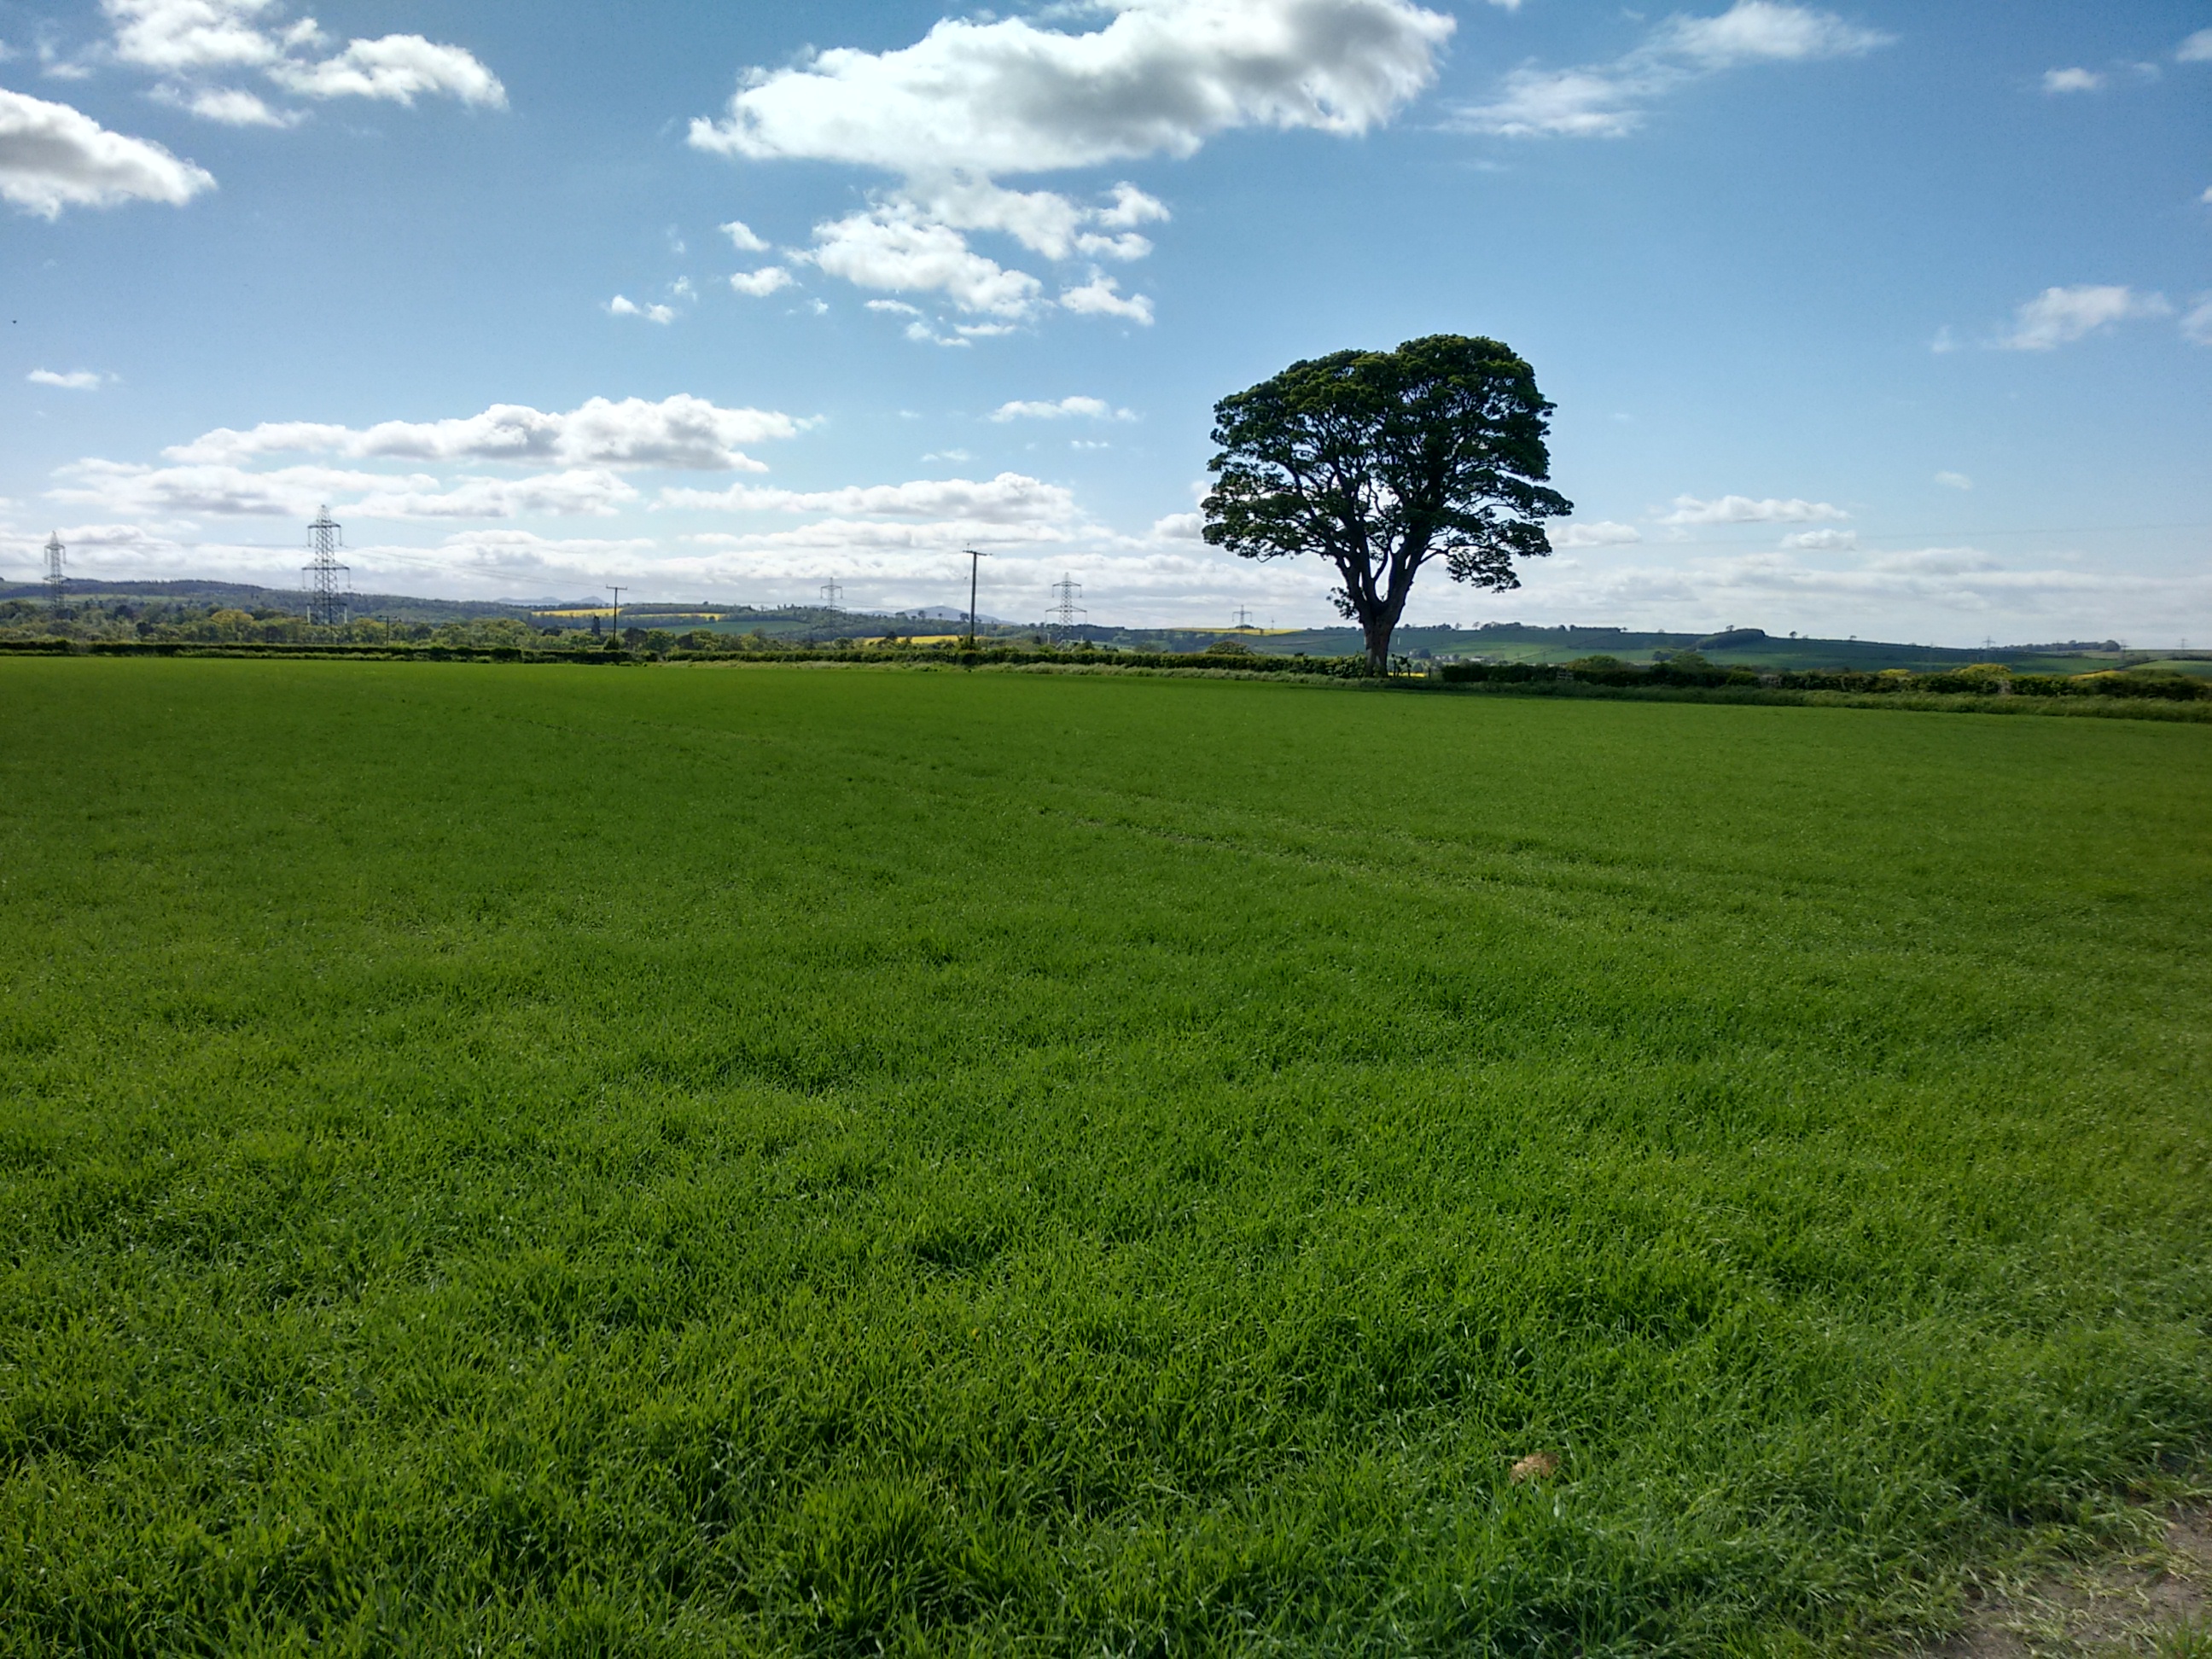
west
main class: Cropland
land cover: Barley
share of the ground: > 75 %
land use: Agriculture (excluding fallow land and kitchen gardens)
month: May
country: GB
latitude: 55.8937
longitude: -2.9398
